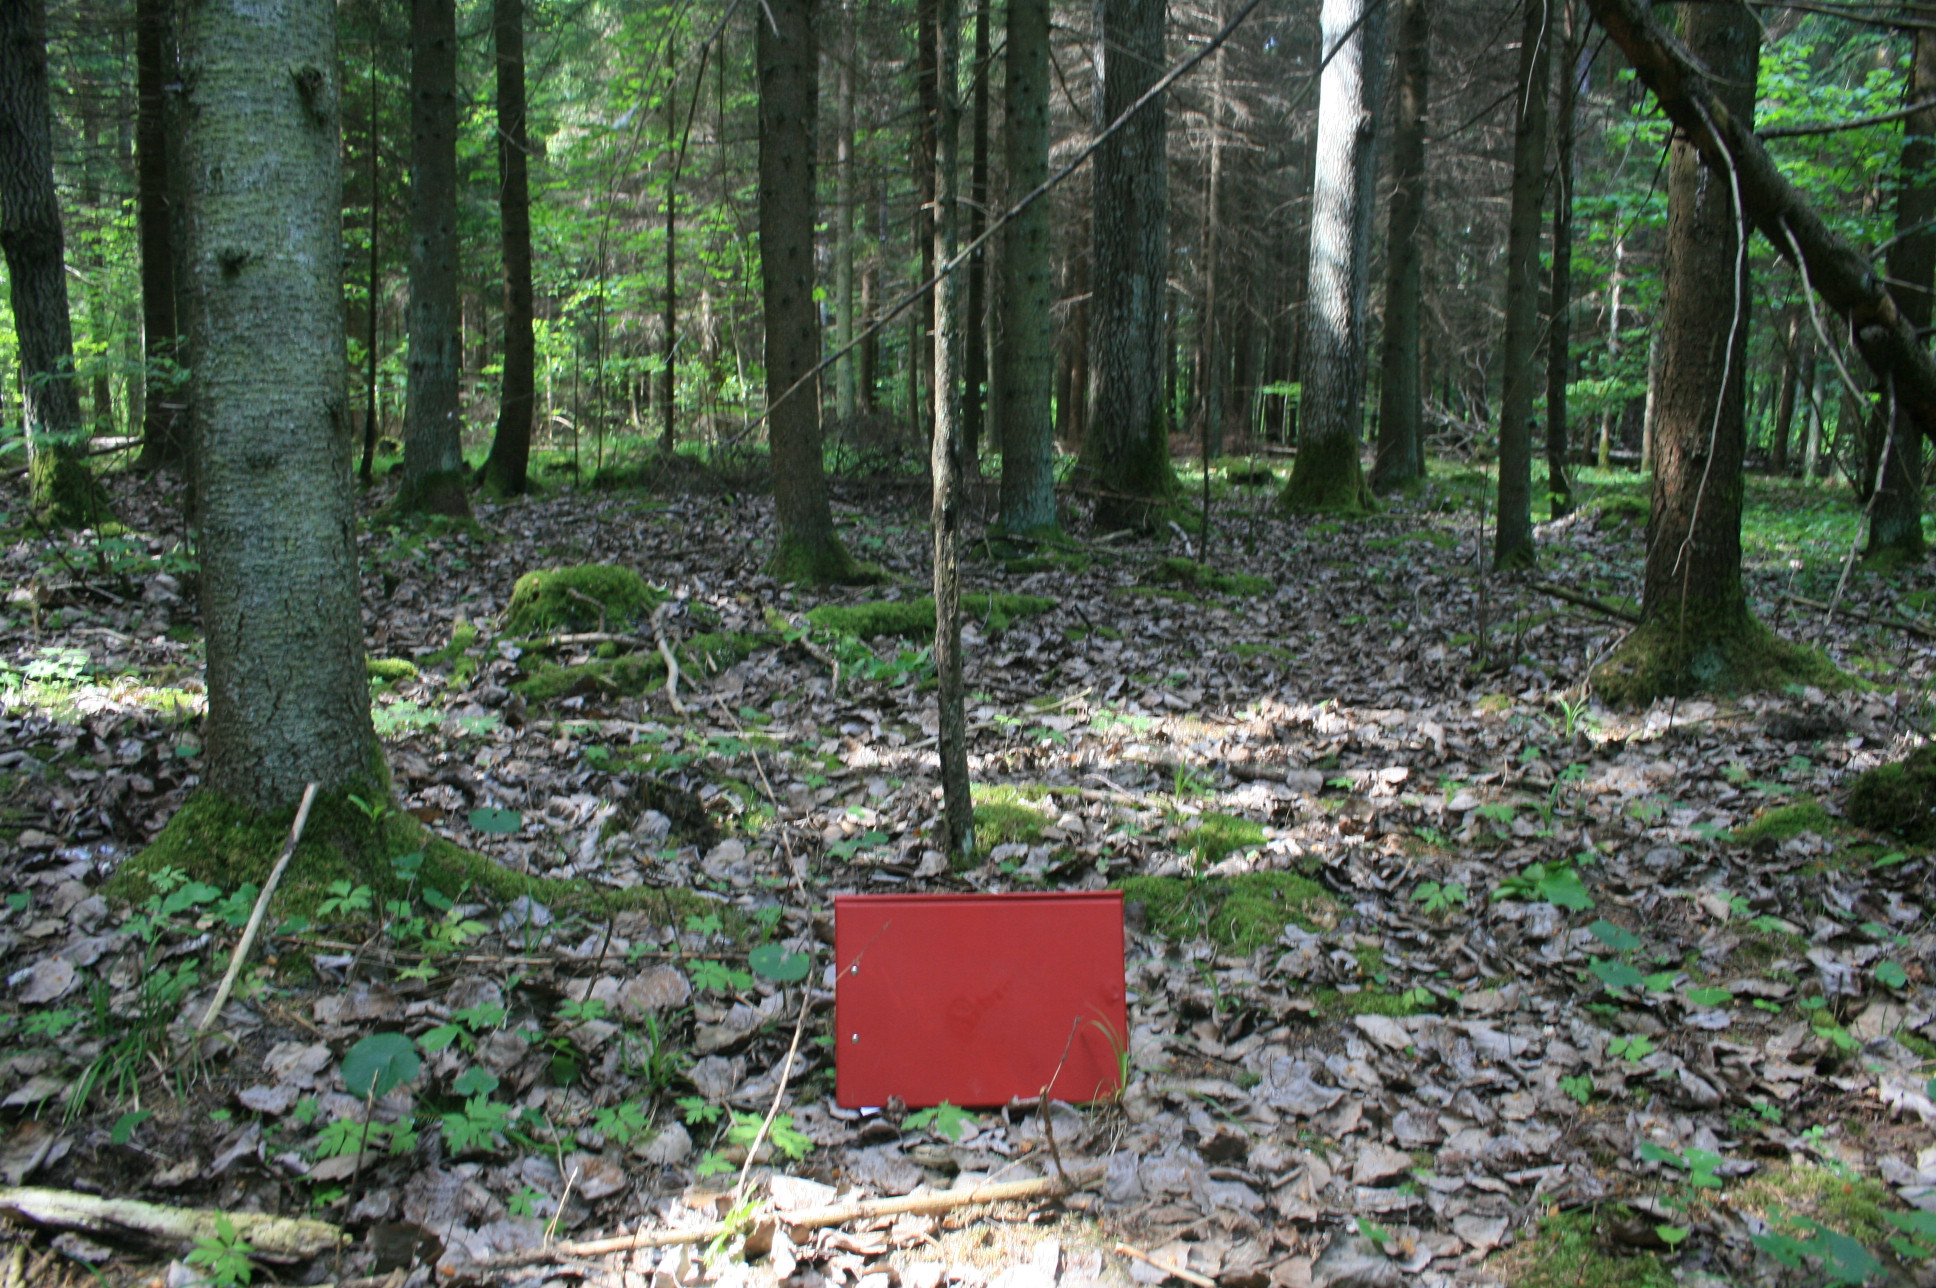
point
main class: Woodland
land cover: Spruce dominated mixed woodland
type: hemiboreal forest and nemoral coniferous forest and mixed broadleaved-coniferous forest
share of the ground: > 75 %
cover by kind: coniferous forest trees 65 %, broadleaved forest trees 30 %, lichens and mosses 5 %
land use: Forestry
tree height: > 5 m
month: June
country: LT
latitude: 56.2246
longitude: 22.3622
